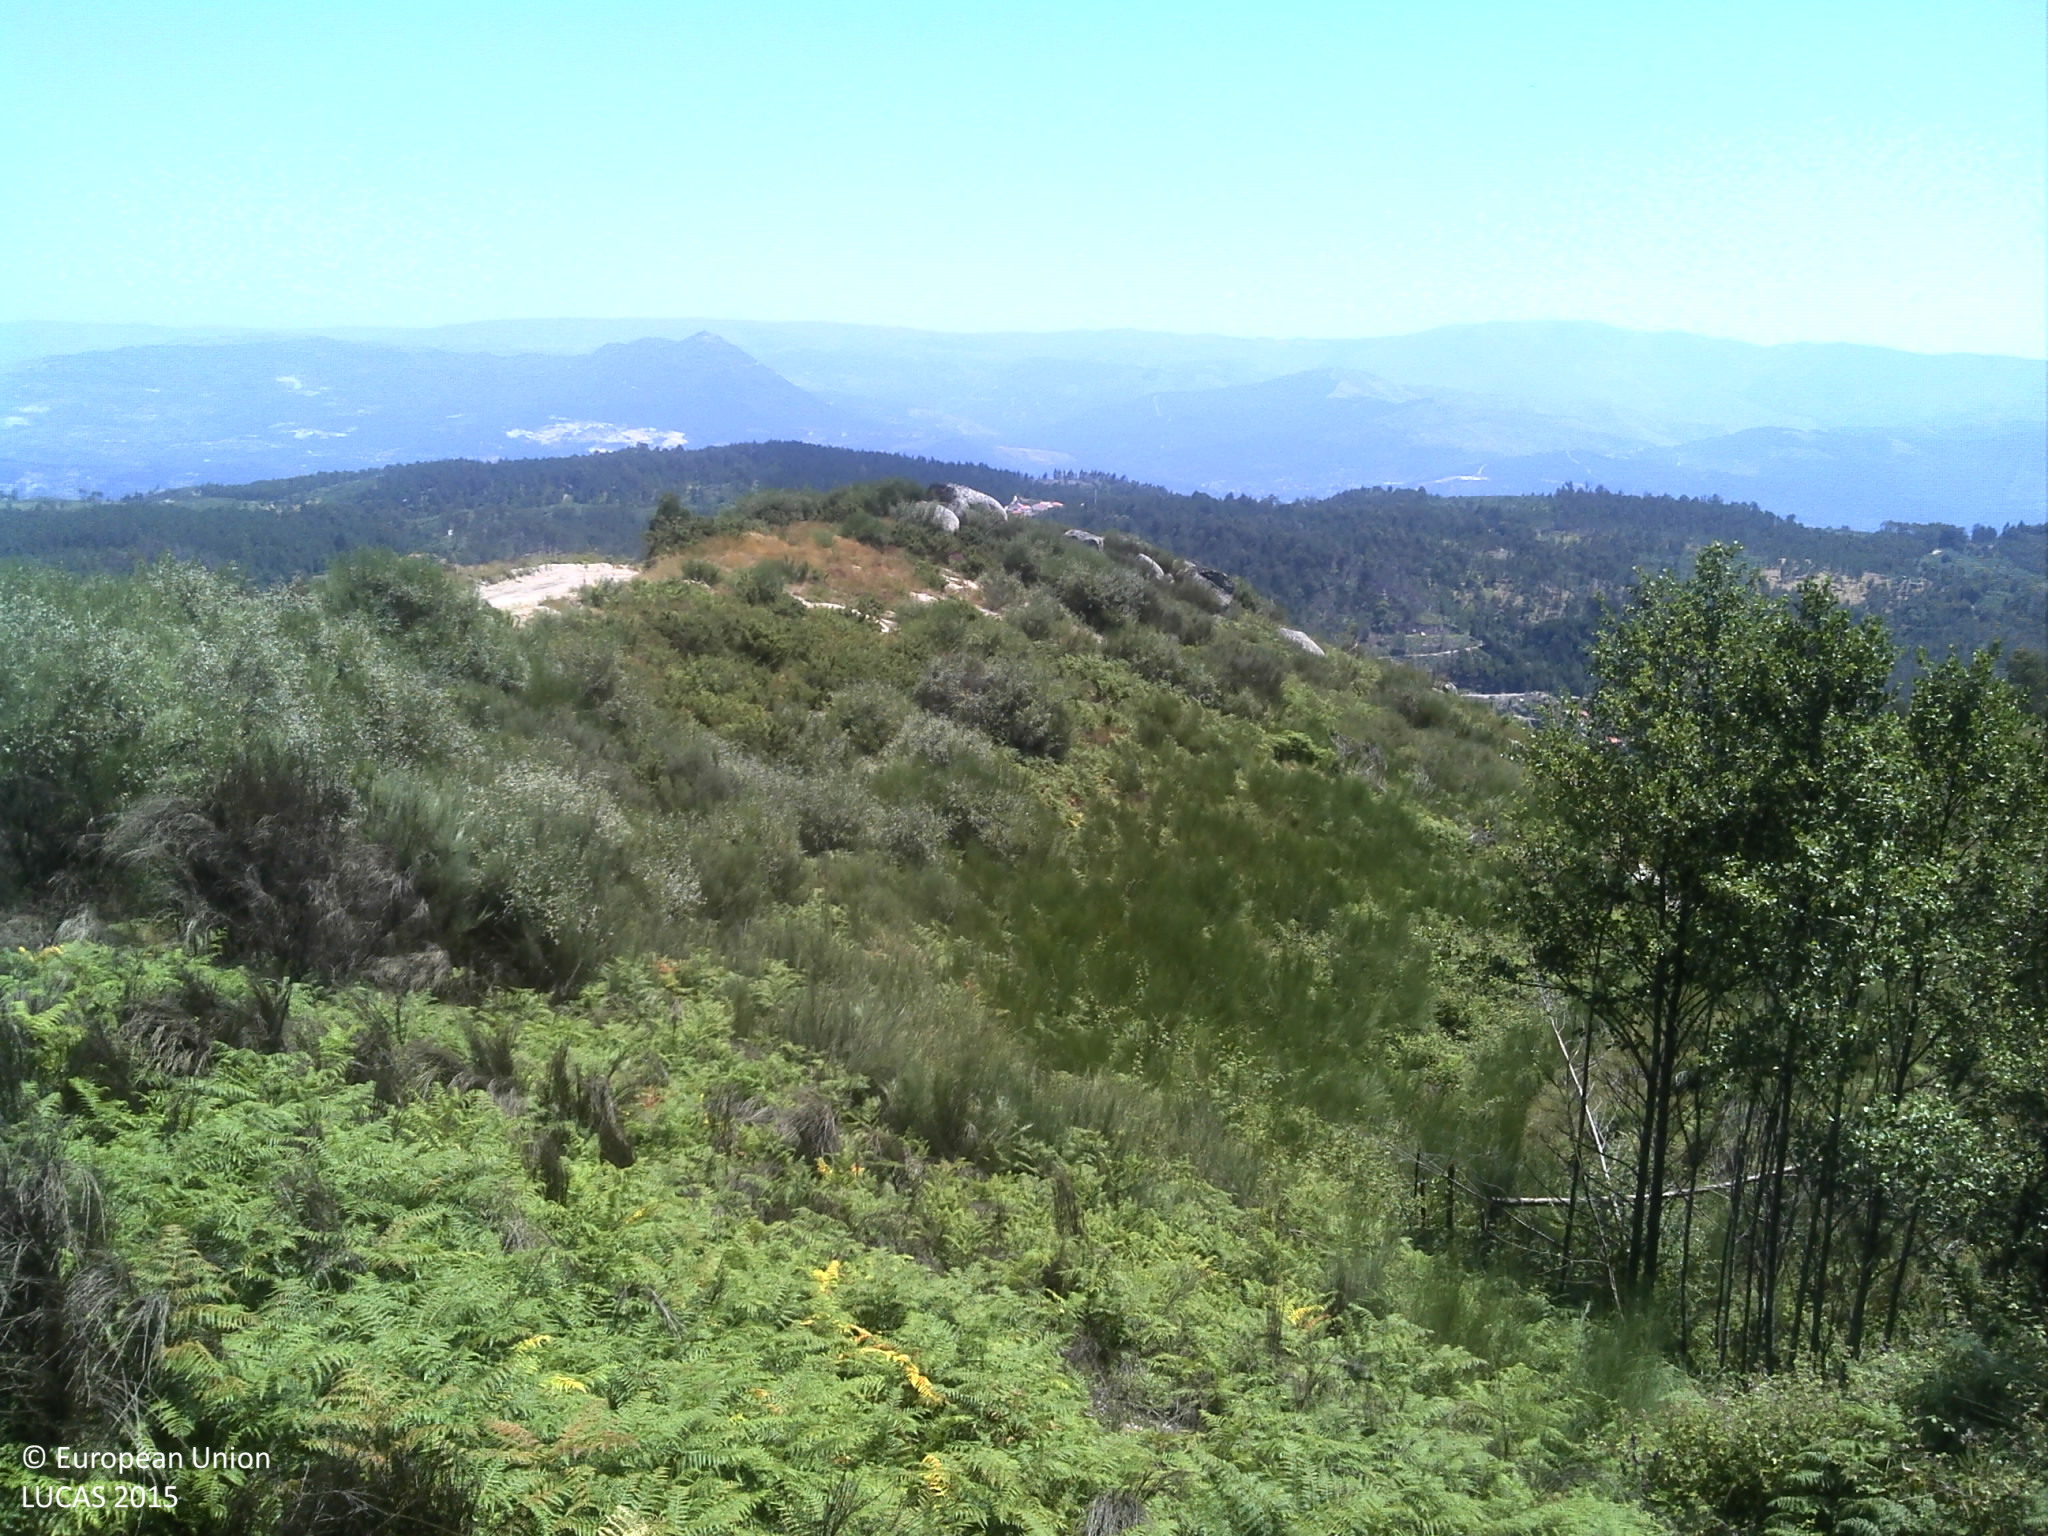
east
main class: Shrubland
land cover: Shrubland without tree cover
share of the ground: > 75 %
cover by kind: shrubs 80 %, herbaceous plants 15 %, unconsolidated bare surface 5 %
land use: Semi-natural and natural areas not in use
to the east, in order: Shrubland without tree cover; Tracks; Shrubland without tree cover; Broadleaved woodland; Tracks; Shrubland without tree cover; Rock outcrops; Shrubland without tree cover; Broadleaved woodland
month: June
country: PT
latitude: 41.4220
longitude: -8.0528
